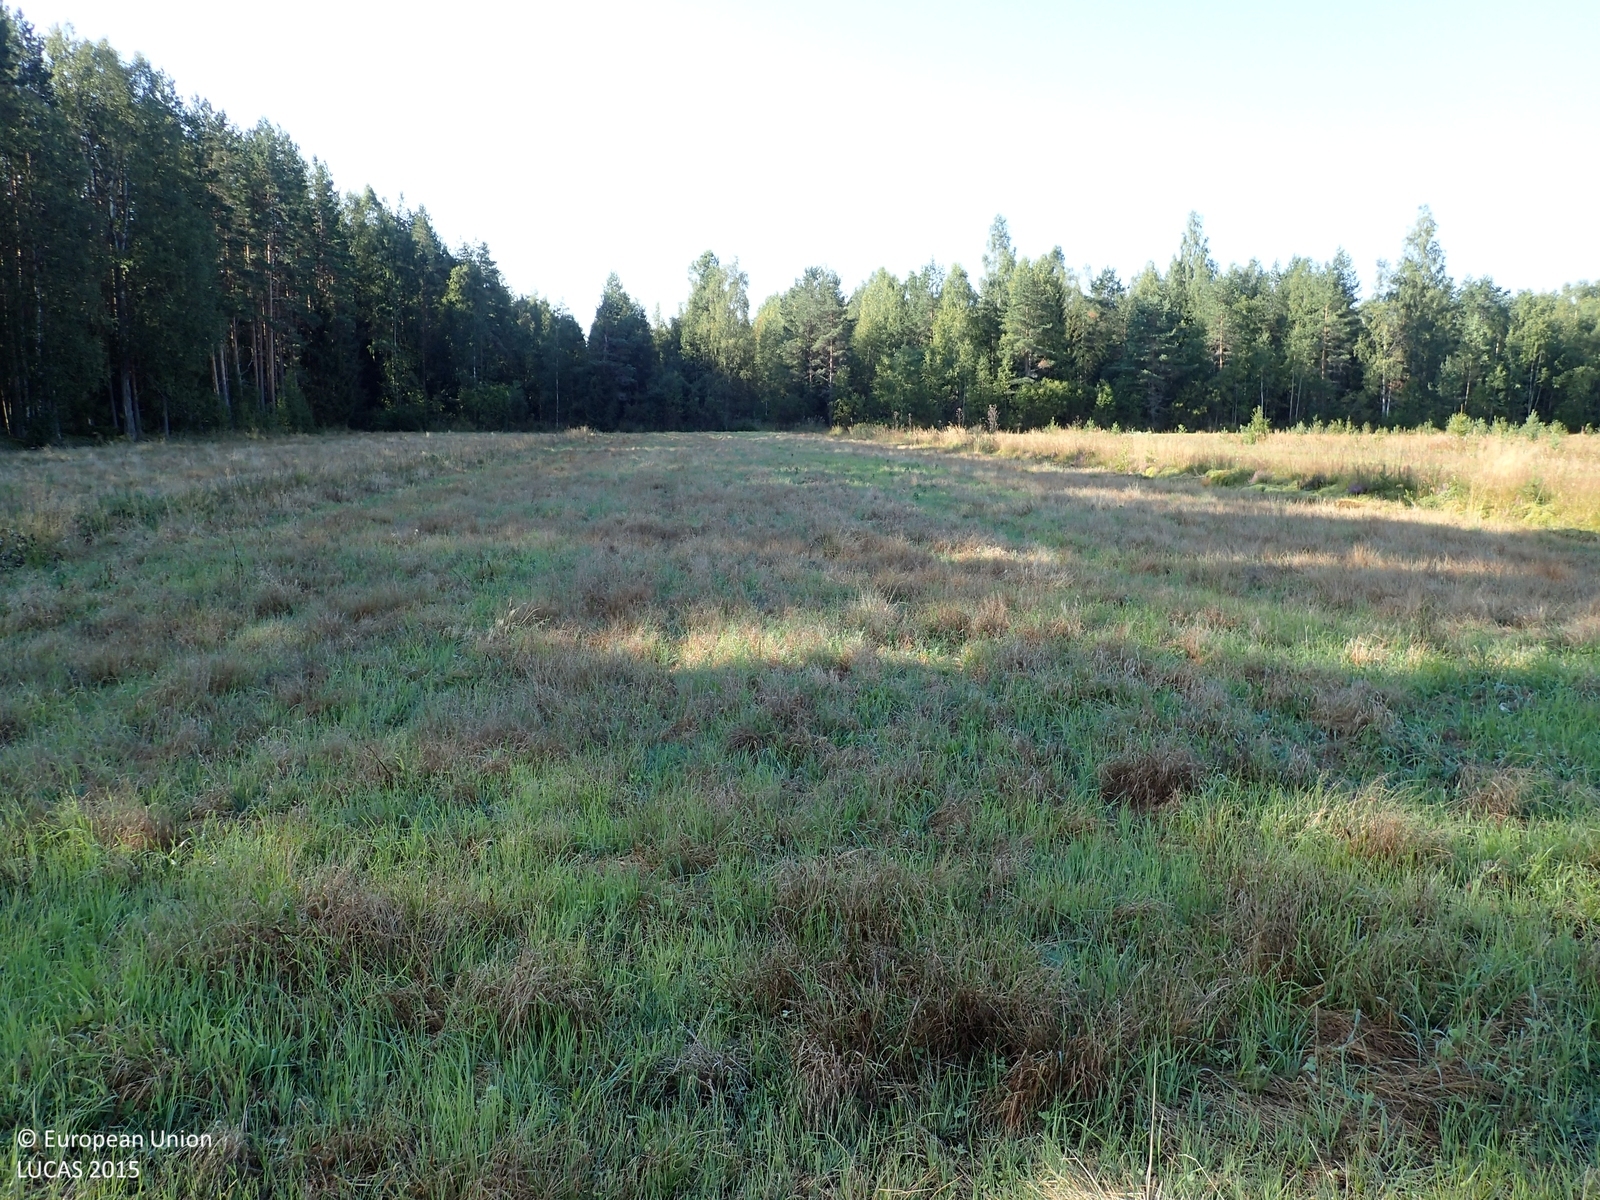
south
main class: Cropland
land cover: Temporary grasslands
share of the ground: > 75 %
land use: Agriculture (excluding fallow land and kitchen gardens)
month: August
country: FI
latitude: 62.4617
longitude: 21.9726
